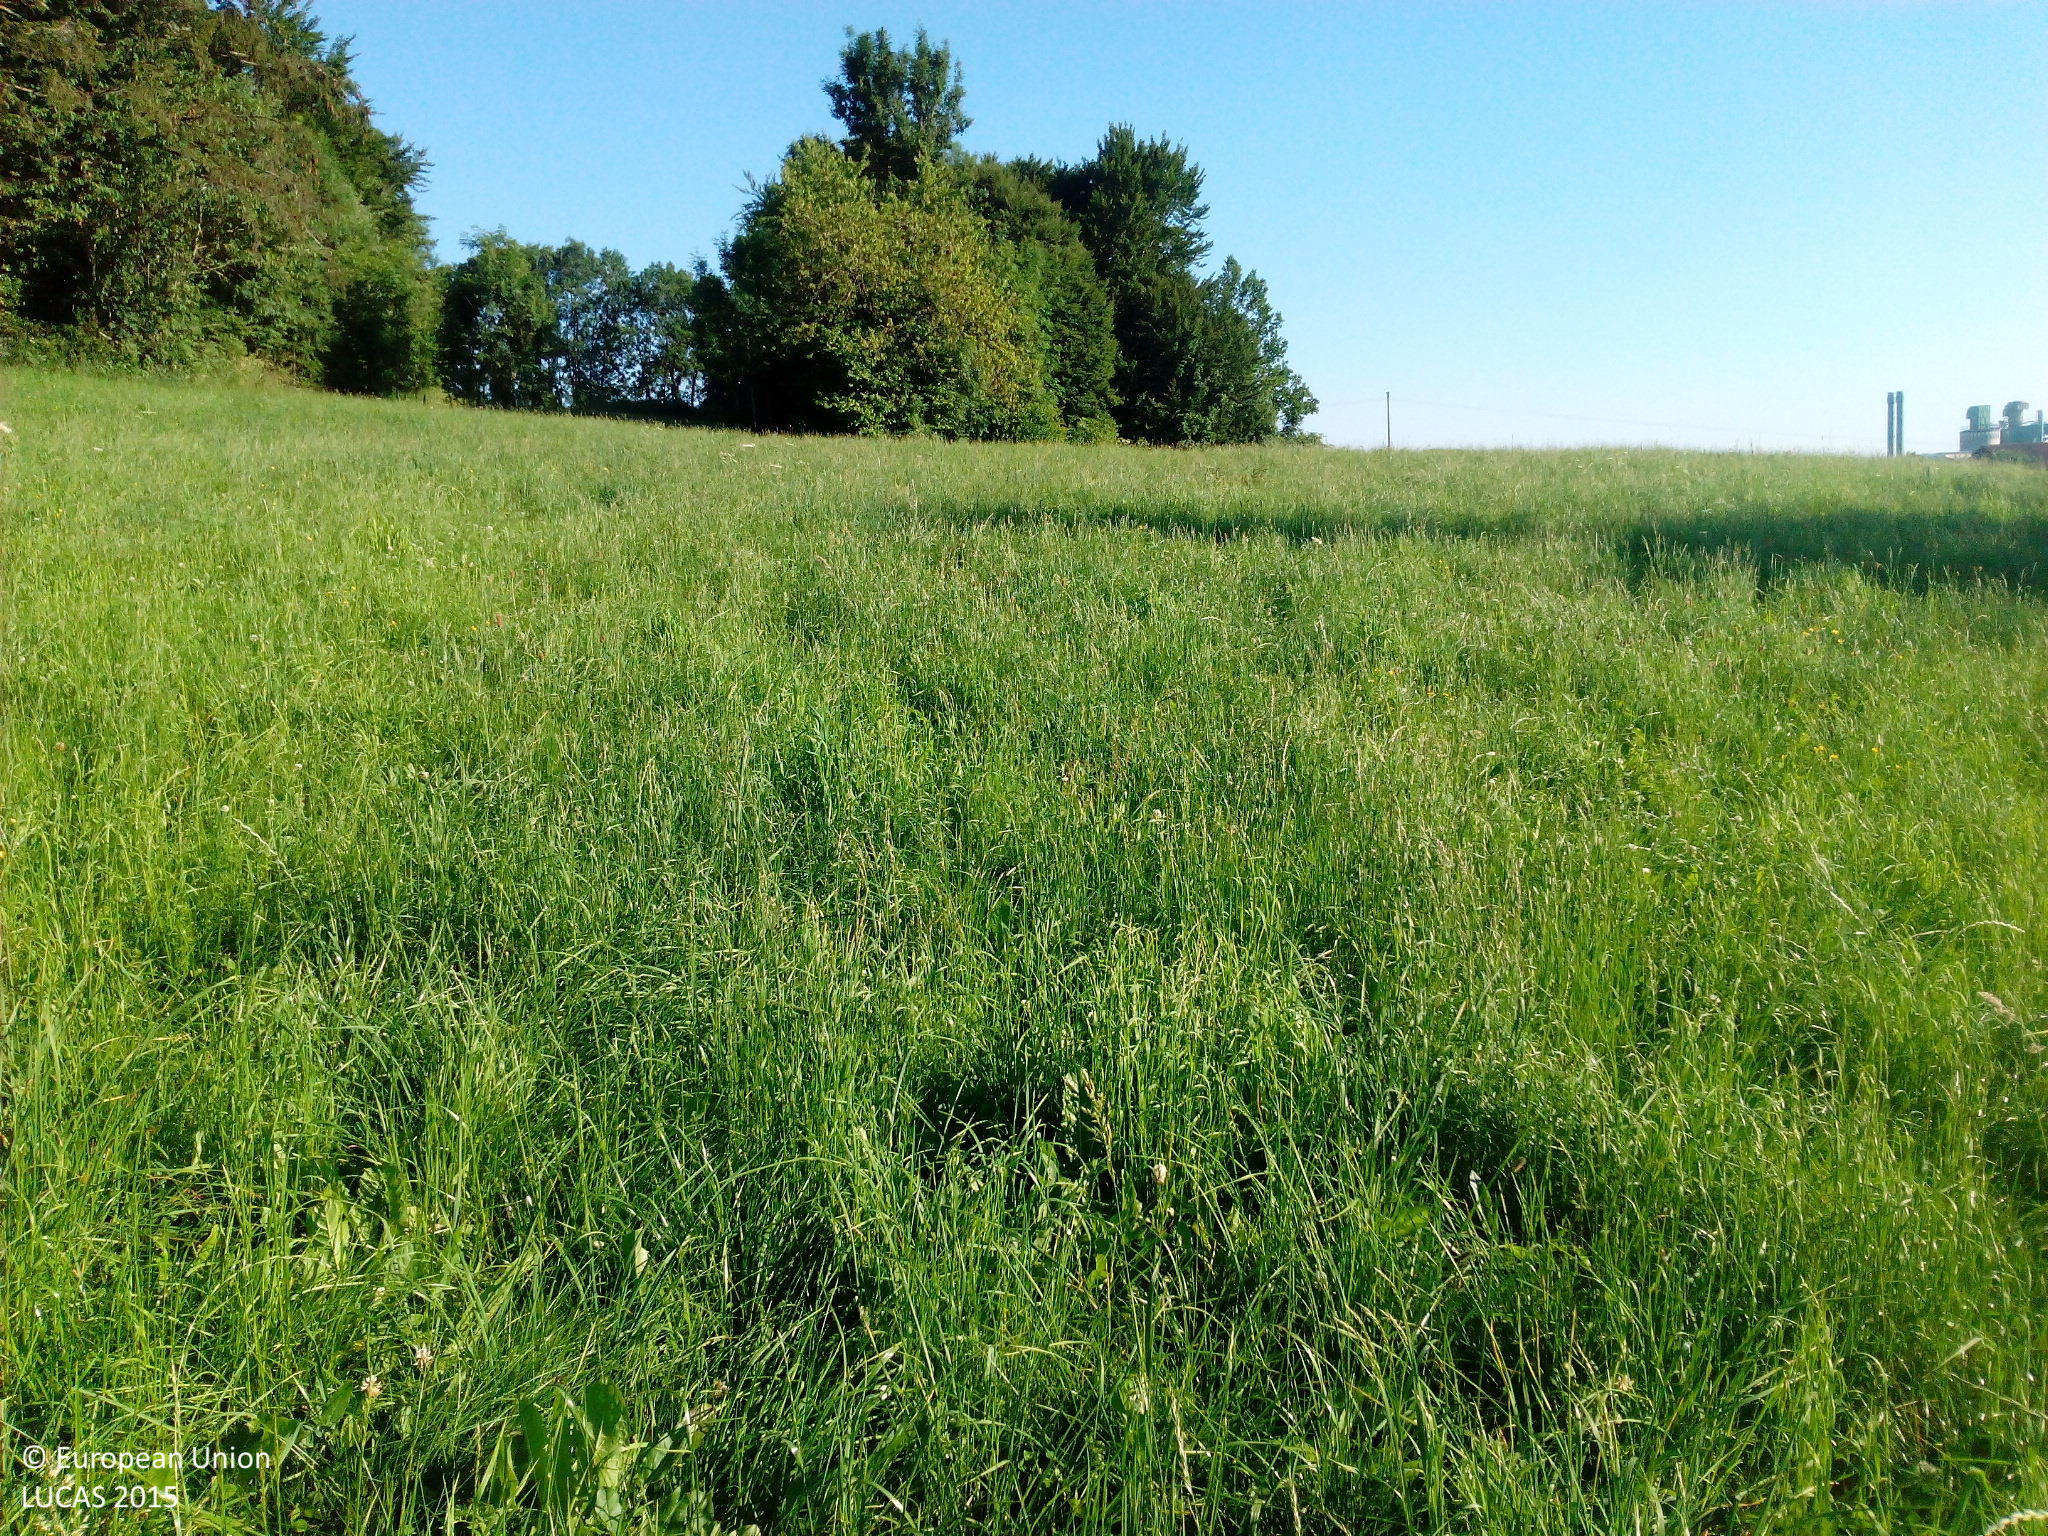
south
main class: Grassland
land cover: Grassland without tree/shrub cover
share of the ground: > 75 %
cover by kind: herbaceous plants 100 %
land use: Agriculture (excluding fallow land and kitchen gardens)
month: July
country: DE
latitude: 48.3295
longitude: 9.3394
